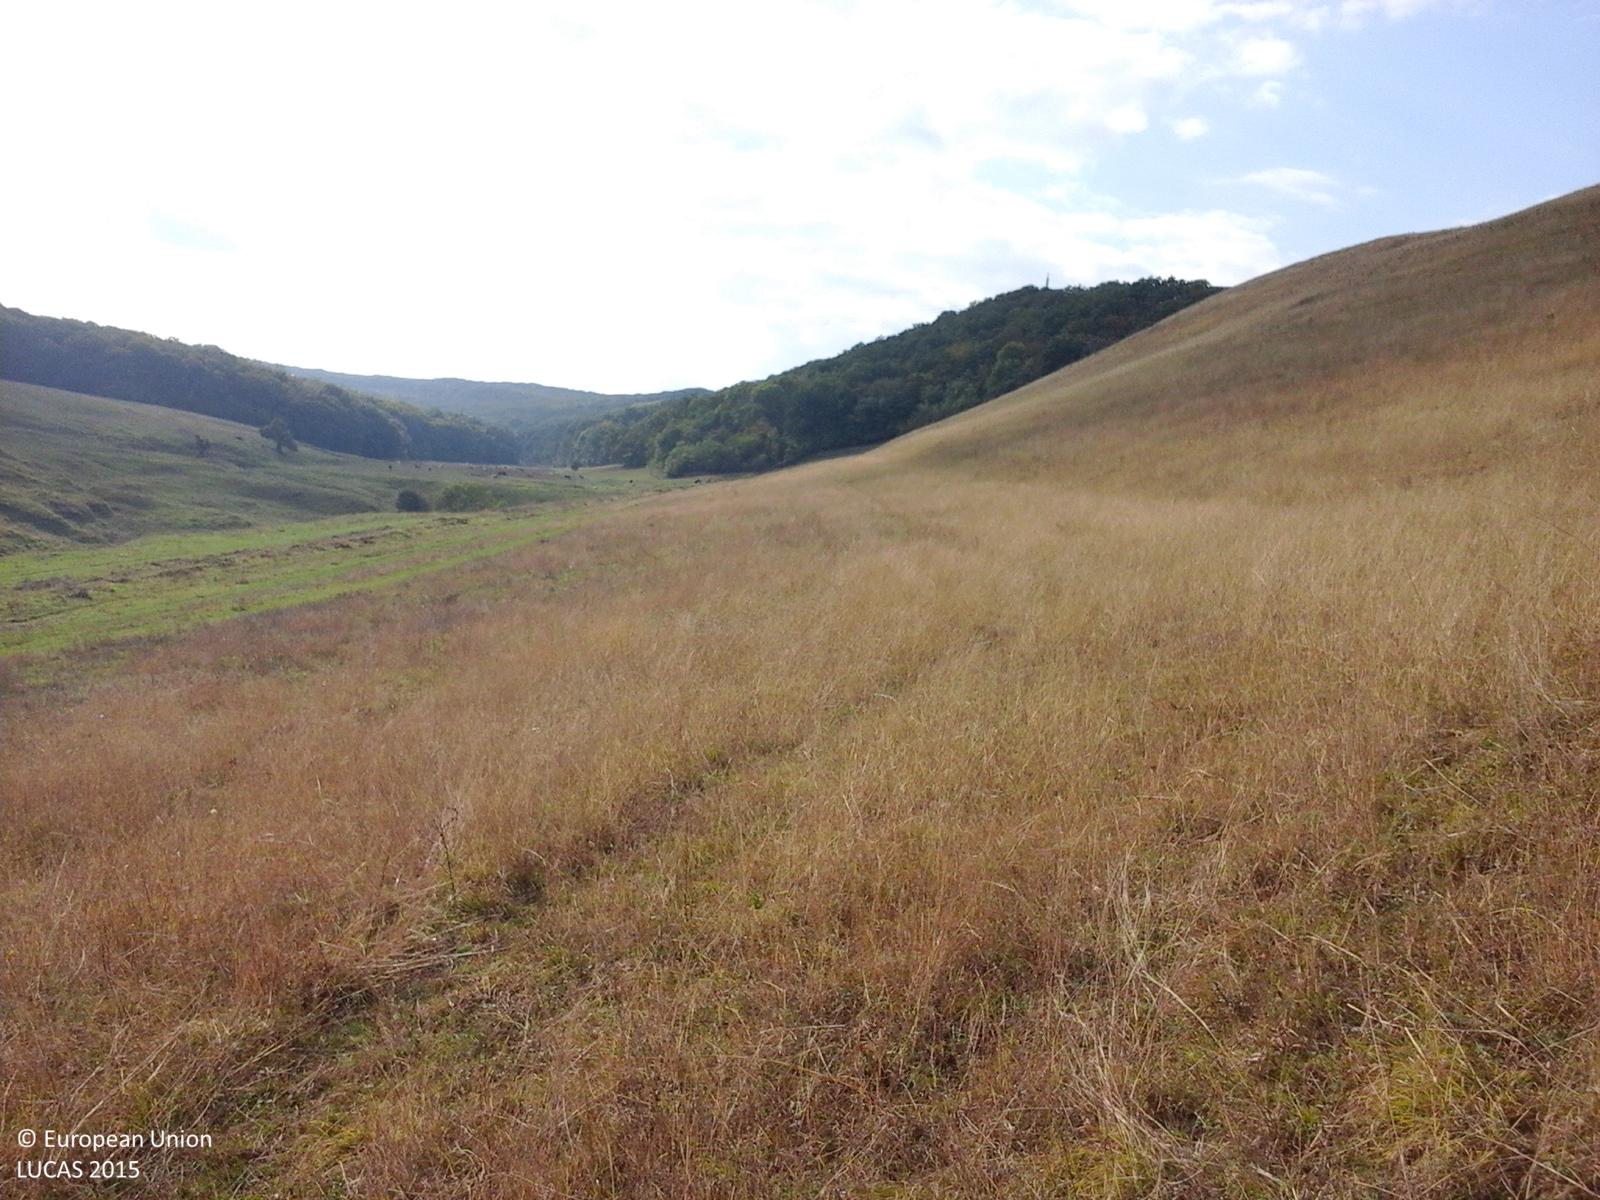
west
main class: Grassland
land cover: Grassland without tree/shrub cover
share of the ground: > 75 %
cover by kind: herbaceous plants 100 %
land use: Agriculture (excluding fallow land and kitchen gardens)
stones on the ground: < 10 %
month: October
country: RO
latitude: 46.1890
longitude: 24.1617
